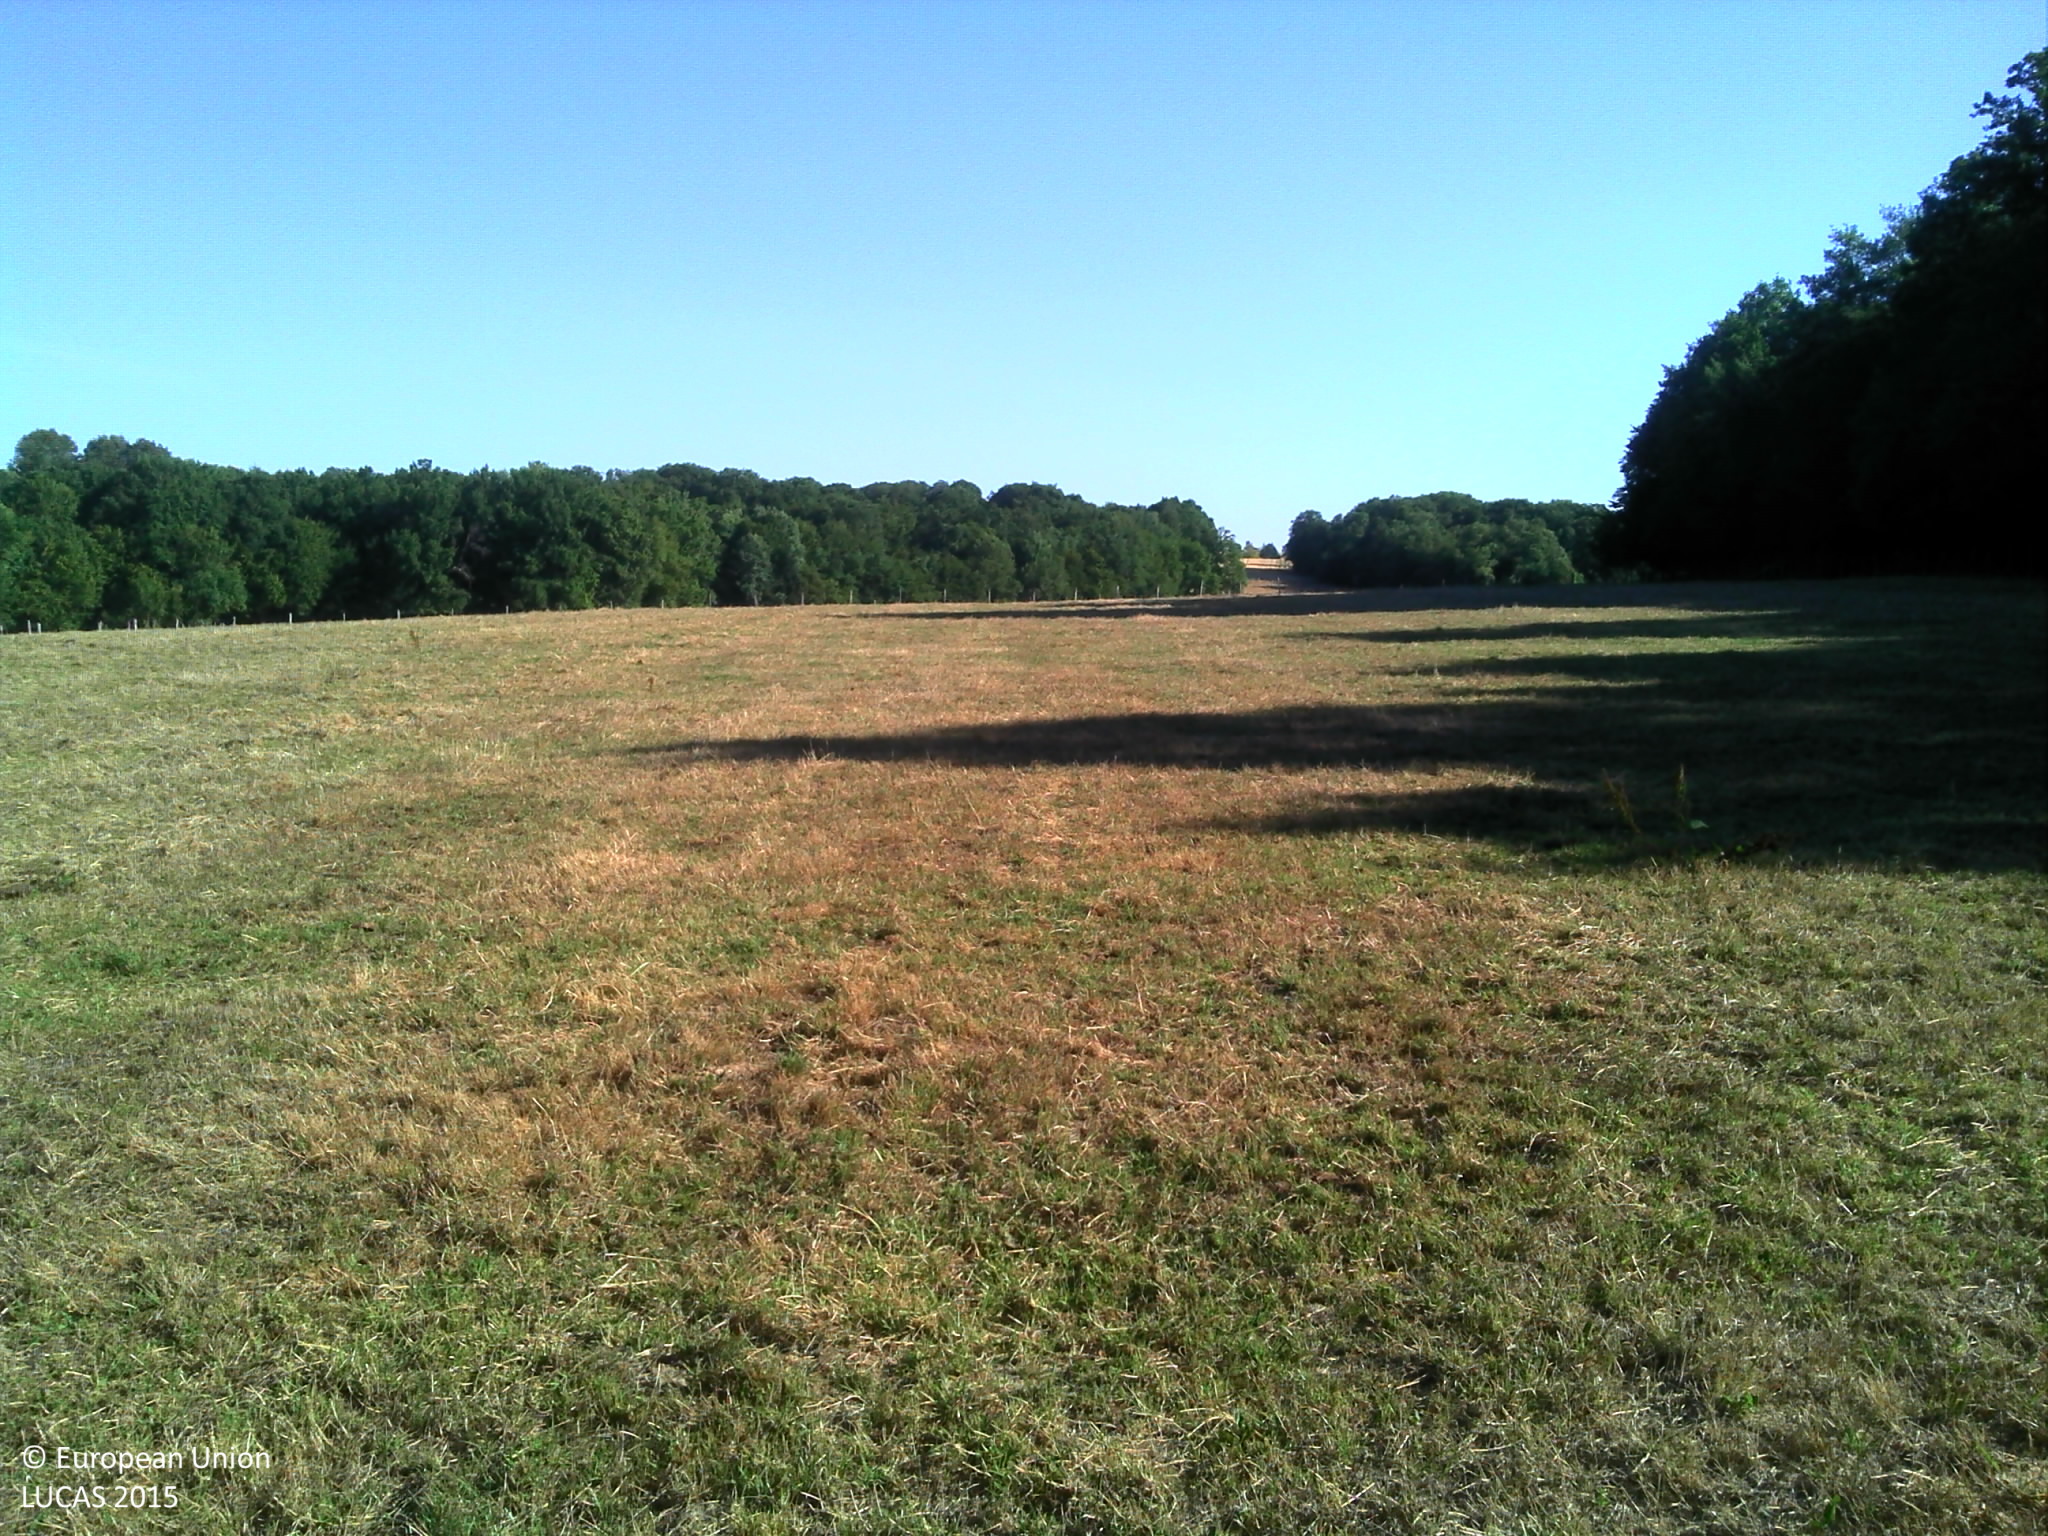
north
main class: Grassland
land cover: Grassland without tree/shrub cover
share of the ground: > 75 %
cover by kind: herbaceous plants 85 %, lichens and mosses 10 %, unconsolidated bare surface 5 %
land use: Agriculture (excluding fallow land and kitchen gardens)
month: August
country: FR
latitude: 48.8030
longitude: 3.4171
